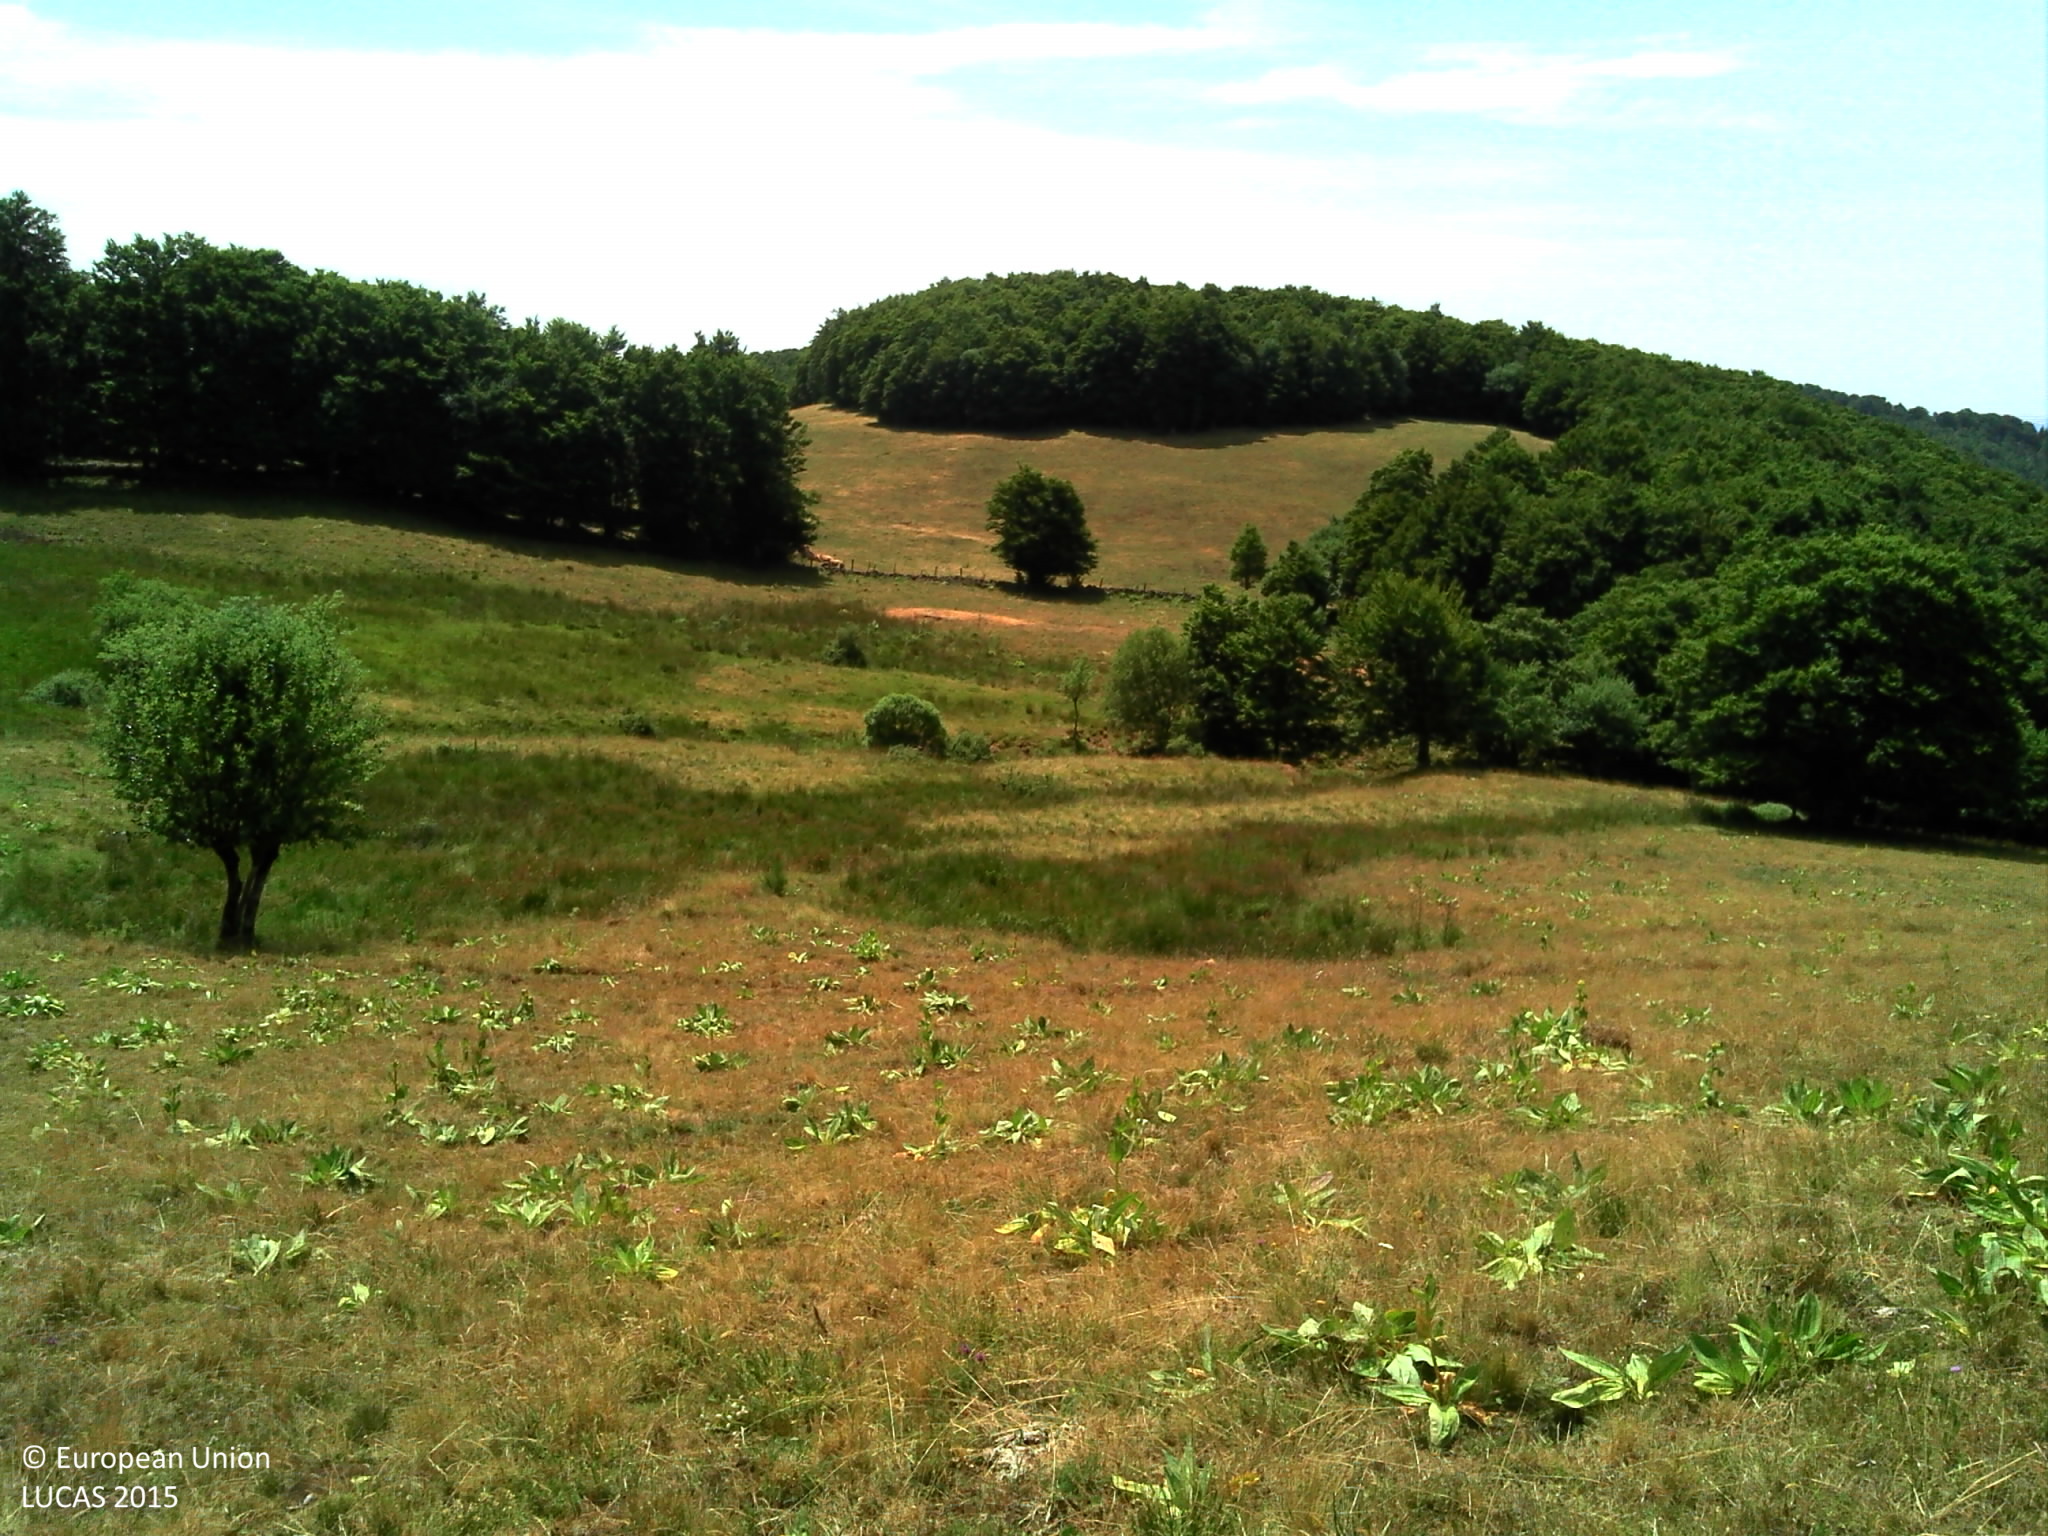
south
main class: Grassland
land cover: Grassland without tree/shrub cover
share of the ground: > 75 %
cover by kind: herbaceous plants 95 %, shrubs 5 %
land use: Agriculture (excluding fallow land and kitchen gardens)
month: July
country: FR
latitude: 44.5692
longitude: 3.0406
